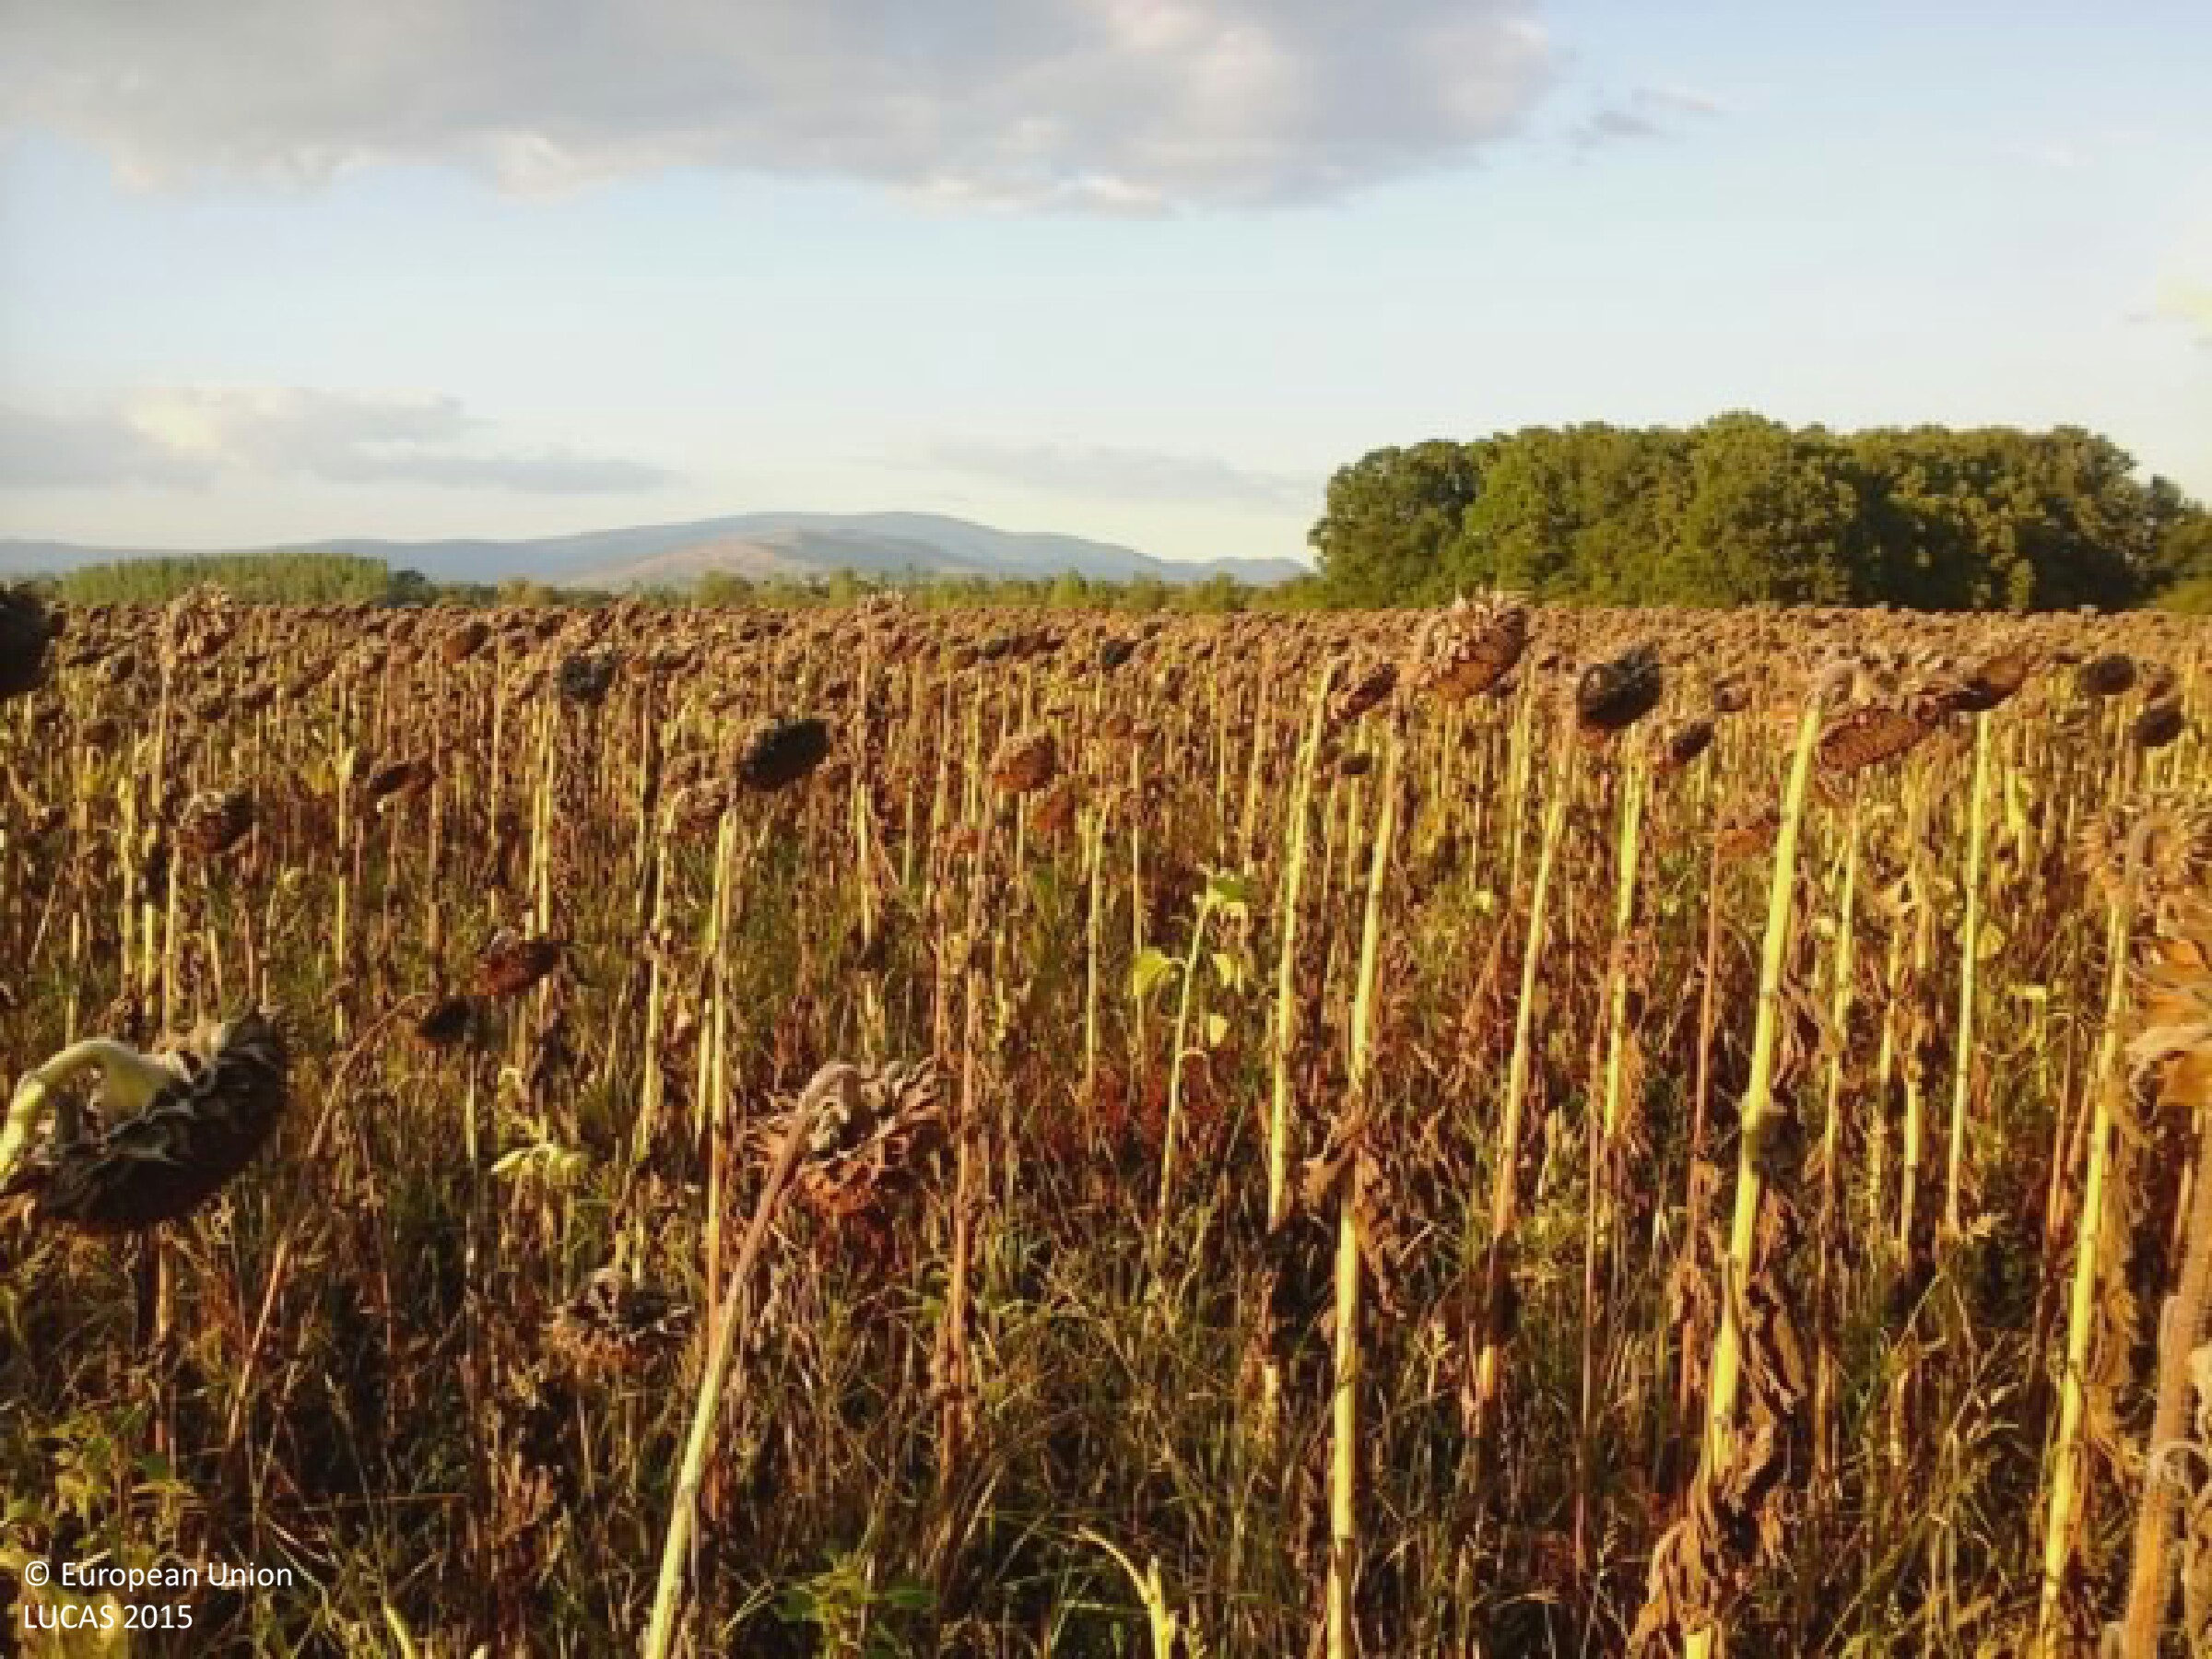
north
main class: Cropland
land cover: Sunflower
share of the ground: > 75 %
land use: Agriculture (excluding fallow land and kitchen gardens)
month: September
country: HU
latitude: 47.7197
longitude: 19.9309
